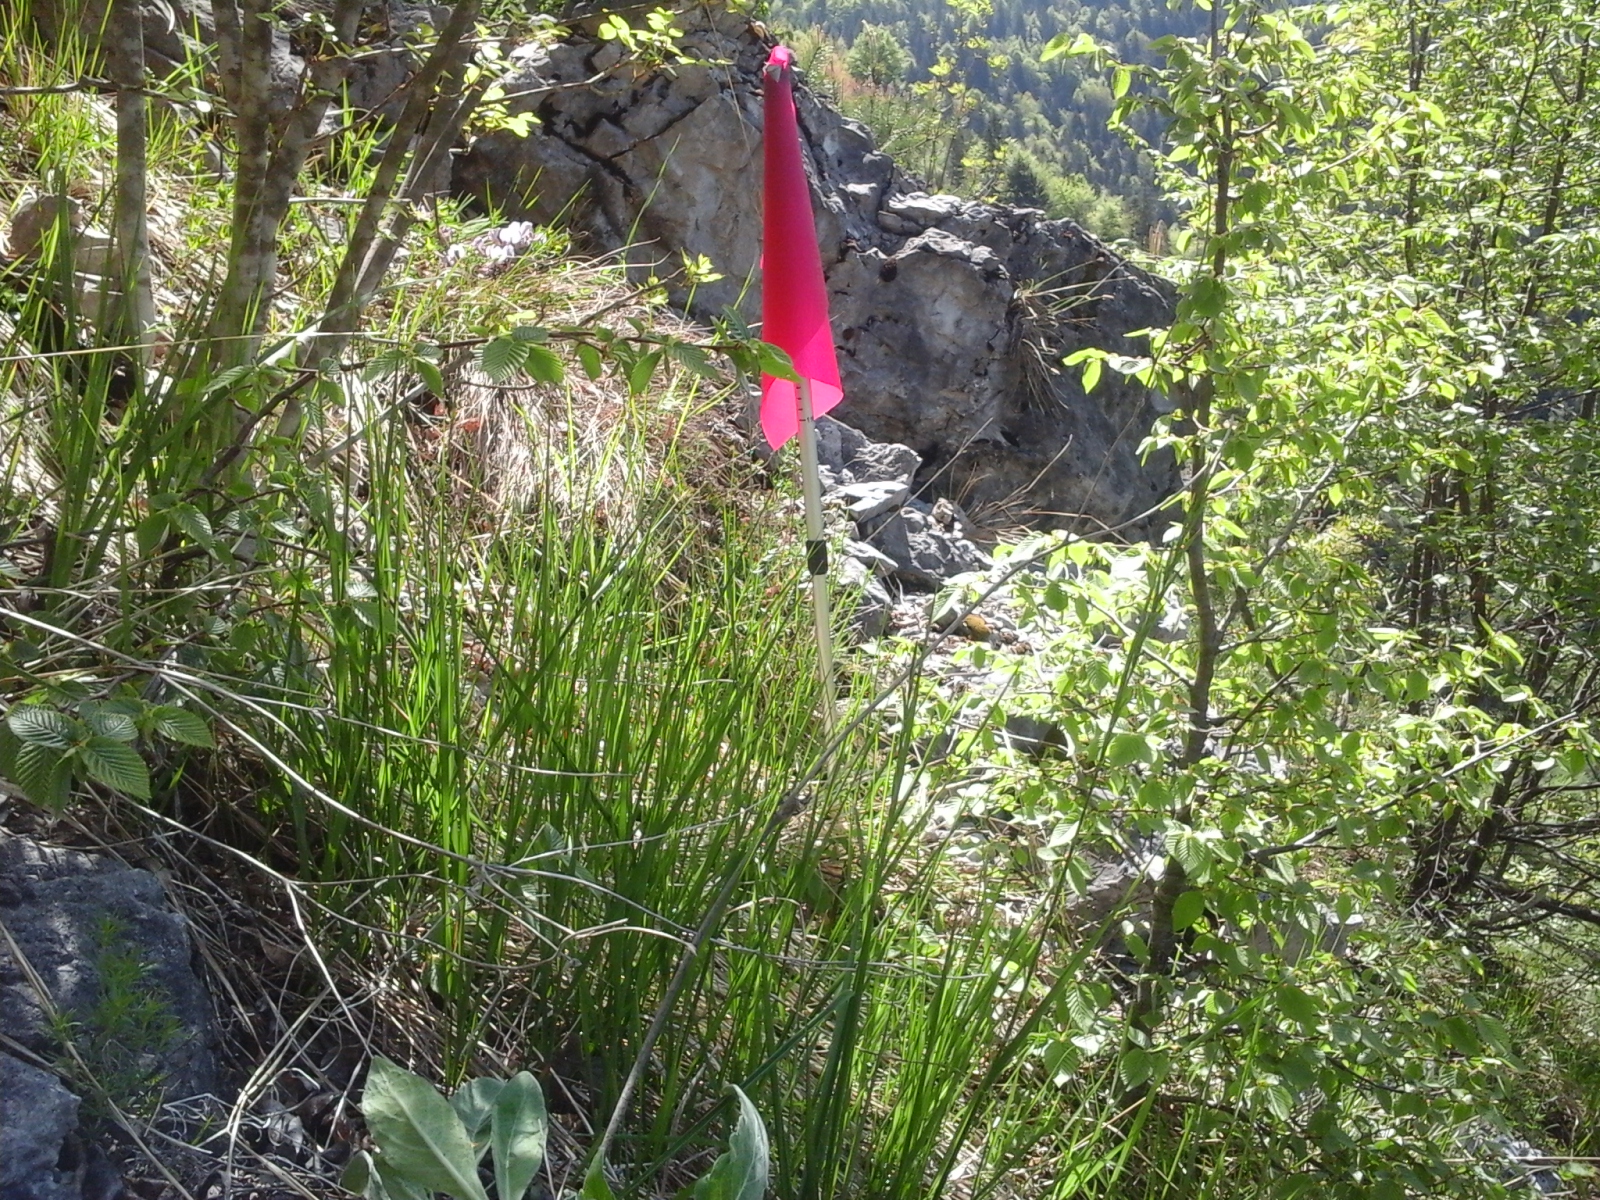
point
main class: Woodland
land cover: Other mixed woodland
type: alpine coniferous forest
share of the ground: > 75 %
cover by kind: shrubs 50 %, herbaceous plants 15 %, unconsolidated bare surface 15 %, coniferous forest trees 10 %, broadleaved forest trees 10 %
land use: Forestry
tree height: > 5 m
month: May
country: IT
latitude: 45.8628
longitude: 10.6559
